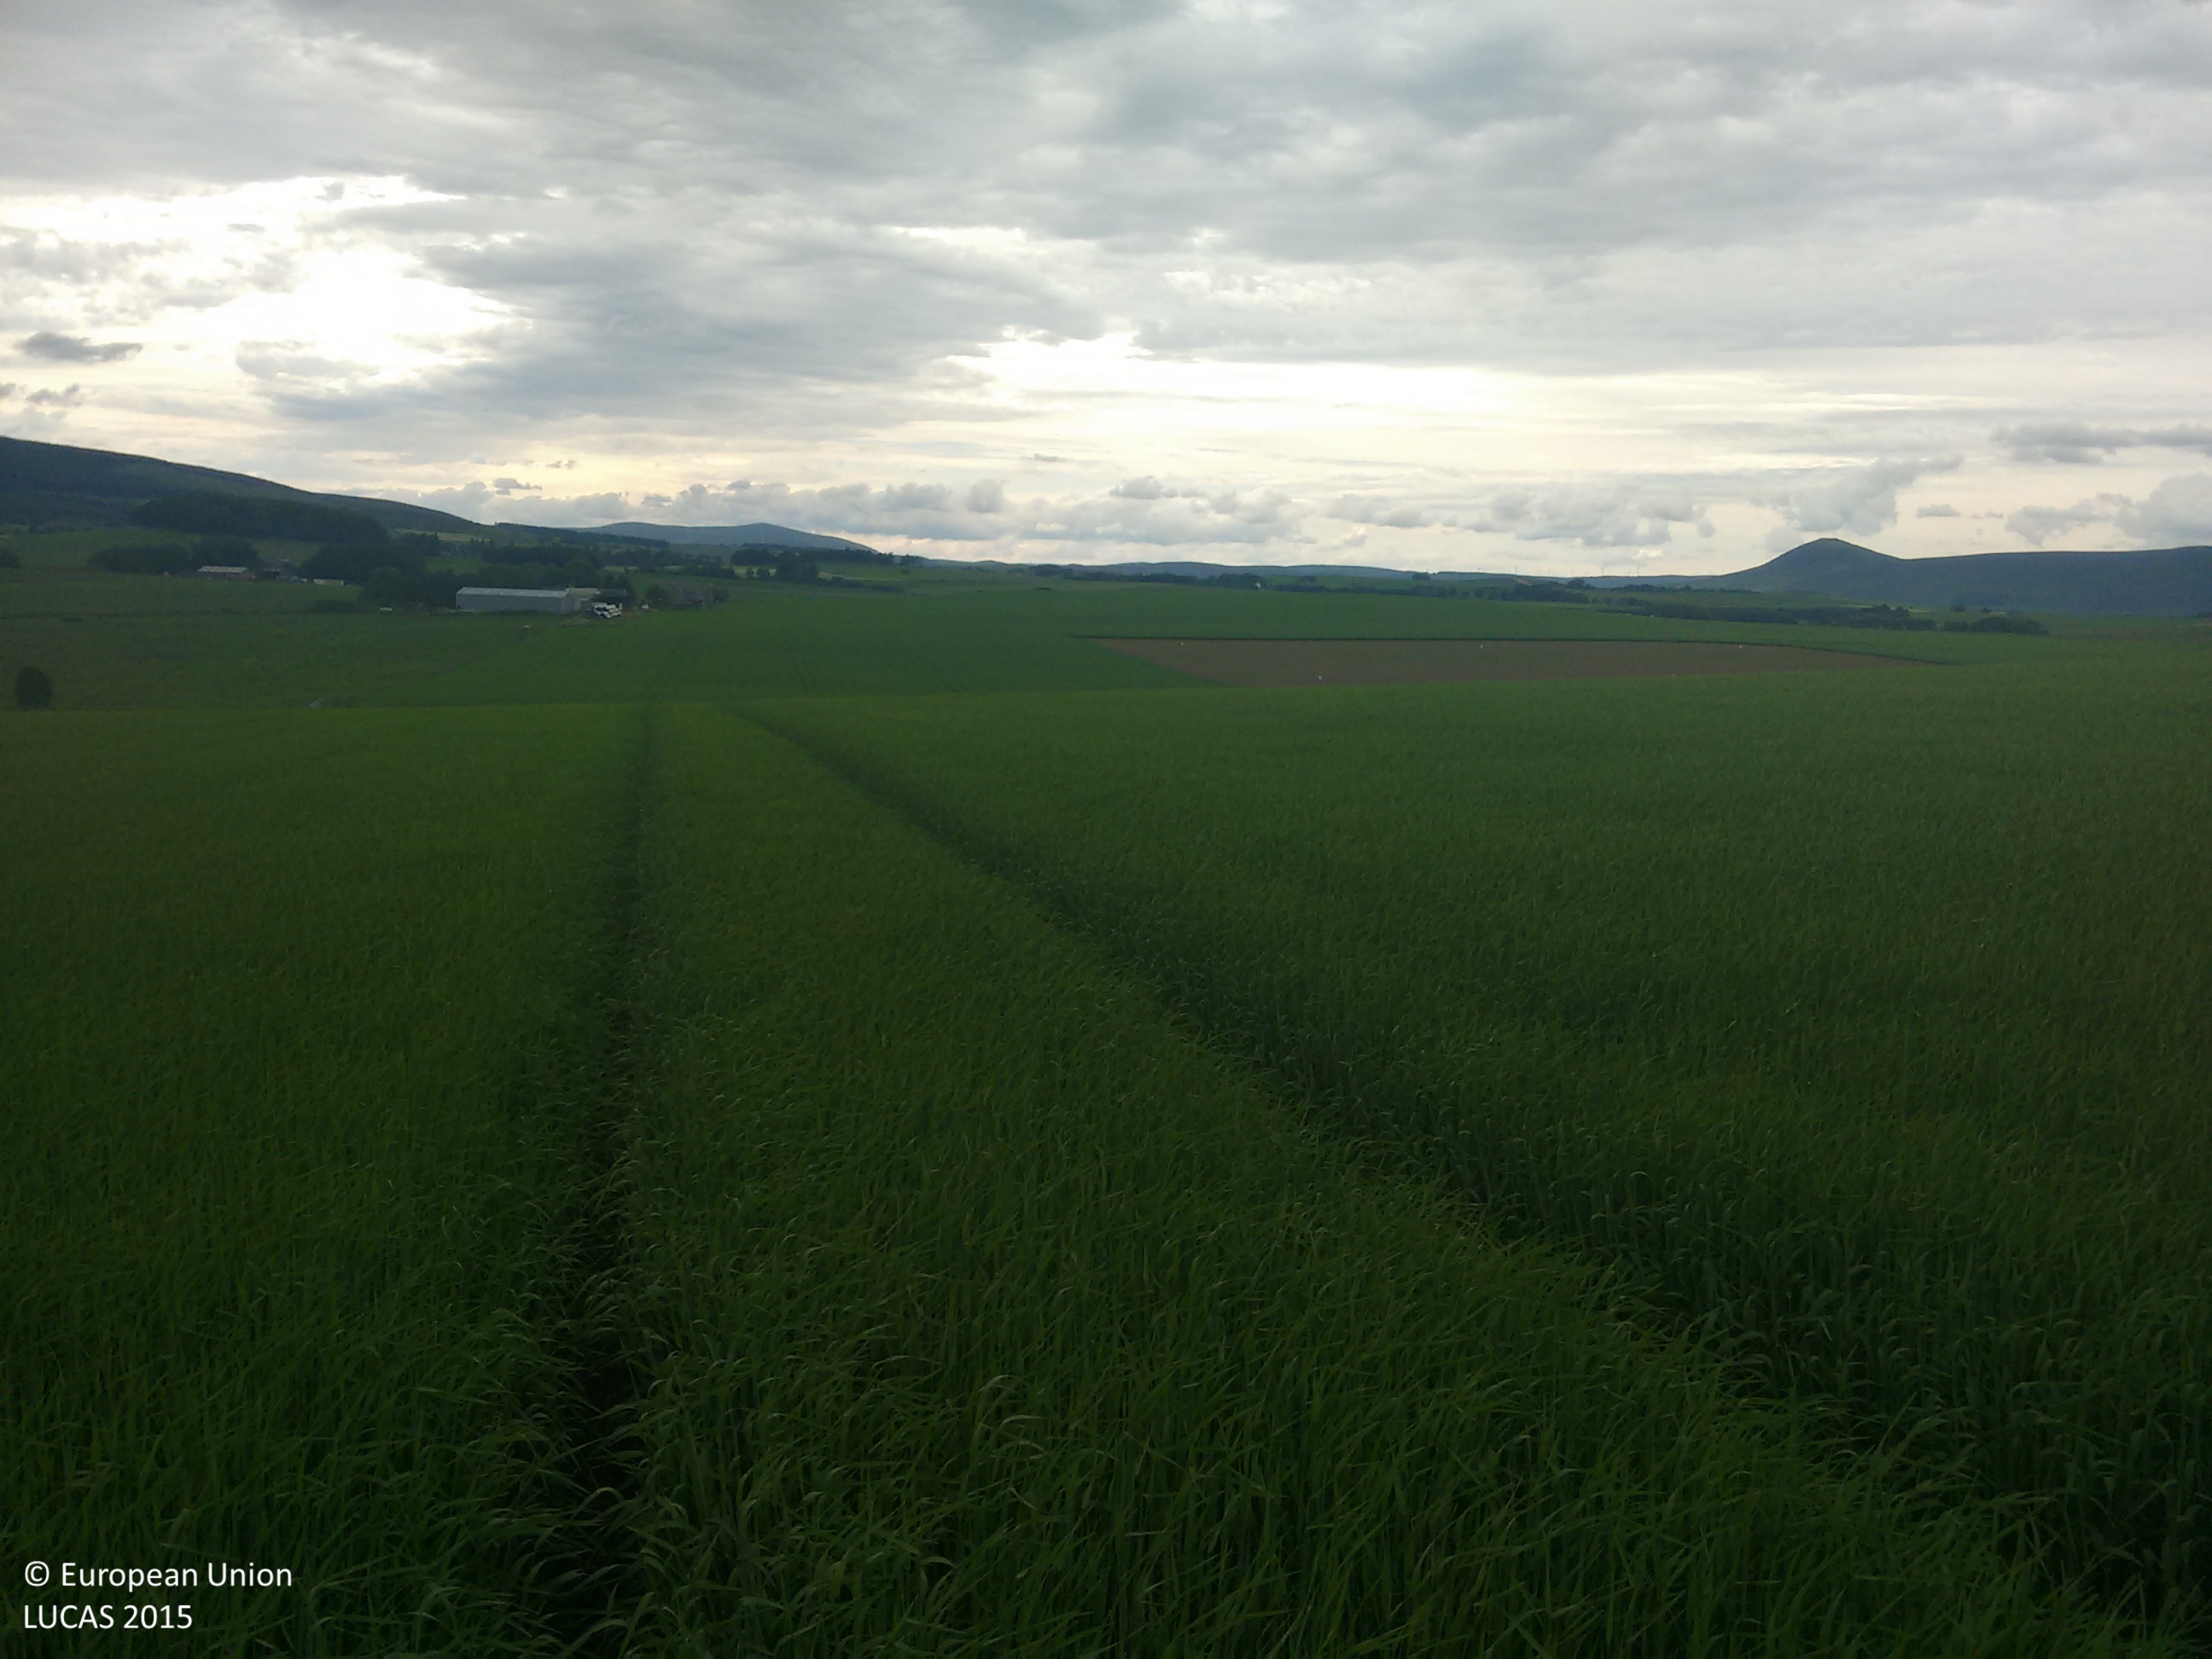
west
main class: Cropland
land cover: Barley
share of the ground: > 75 %
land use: Agriculture (excluding fallow land and kitchen gardens)
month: July
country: GB
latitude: 57.3194
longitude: -2.7272
